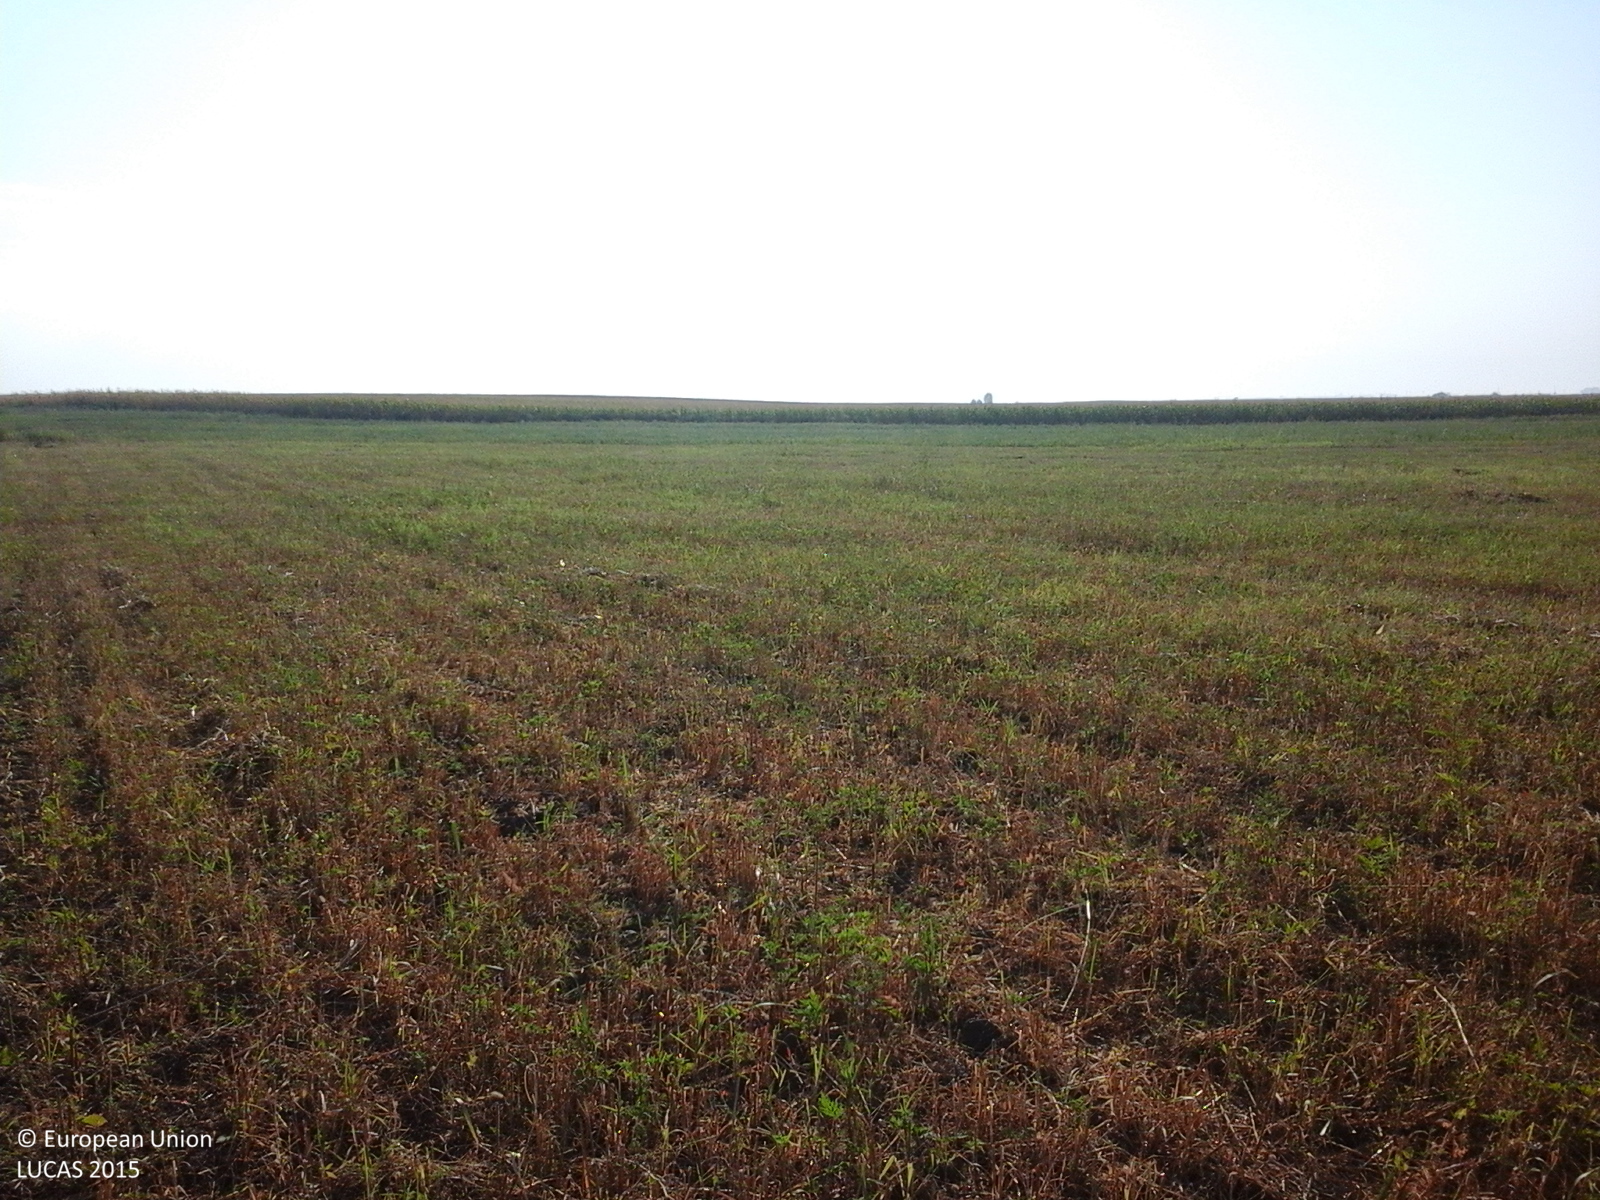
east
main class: Cropland
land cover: Oats
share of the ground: > 75 %
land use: Agriculture (excluding fallow land and kitchen gardens)
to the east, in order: Oats; Maize
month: August
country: RO
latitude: 44.0669
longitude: 23.2168
